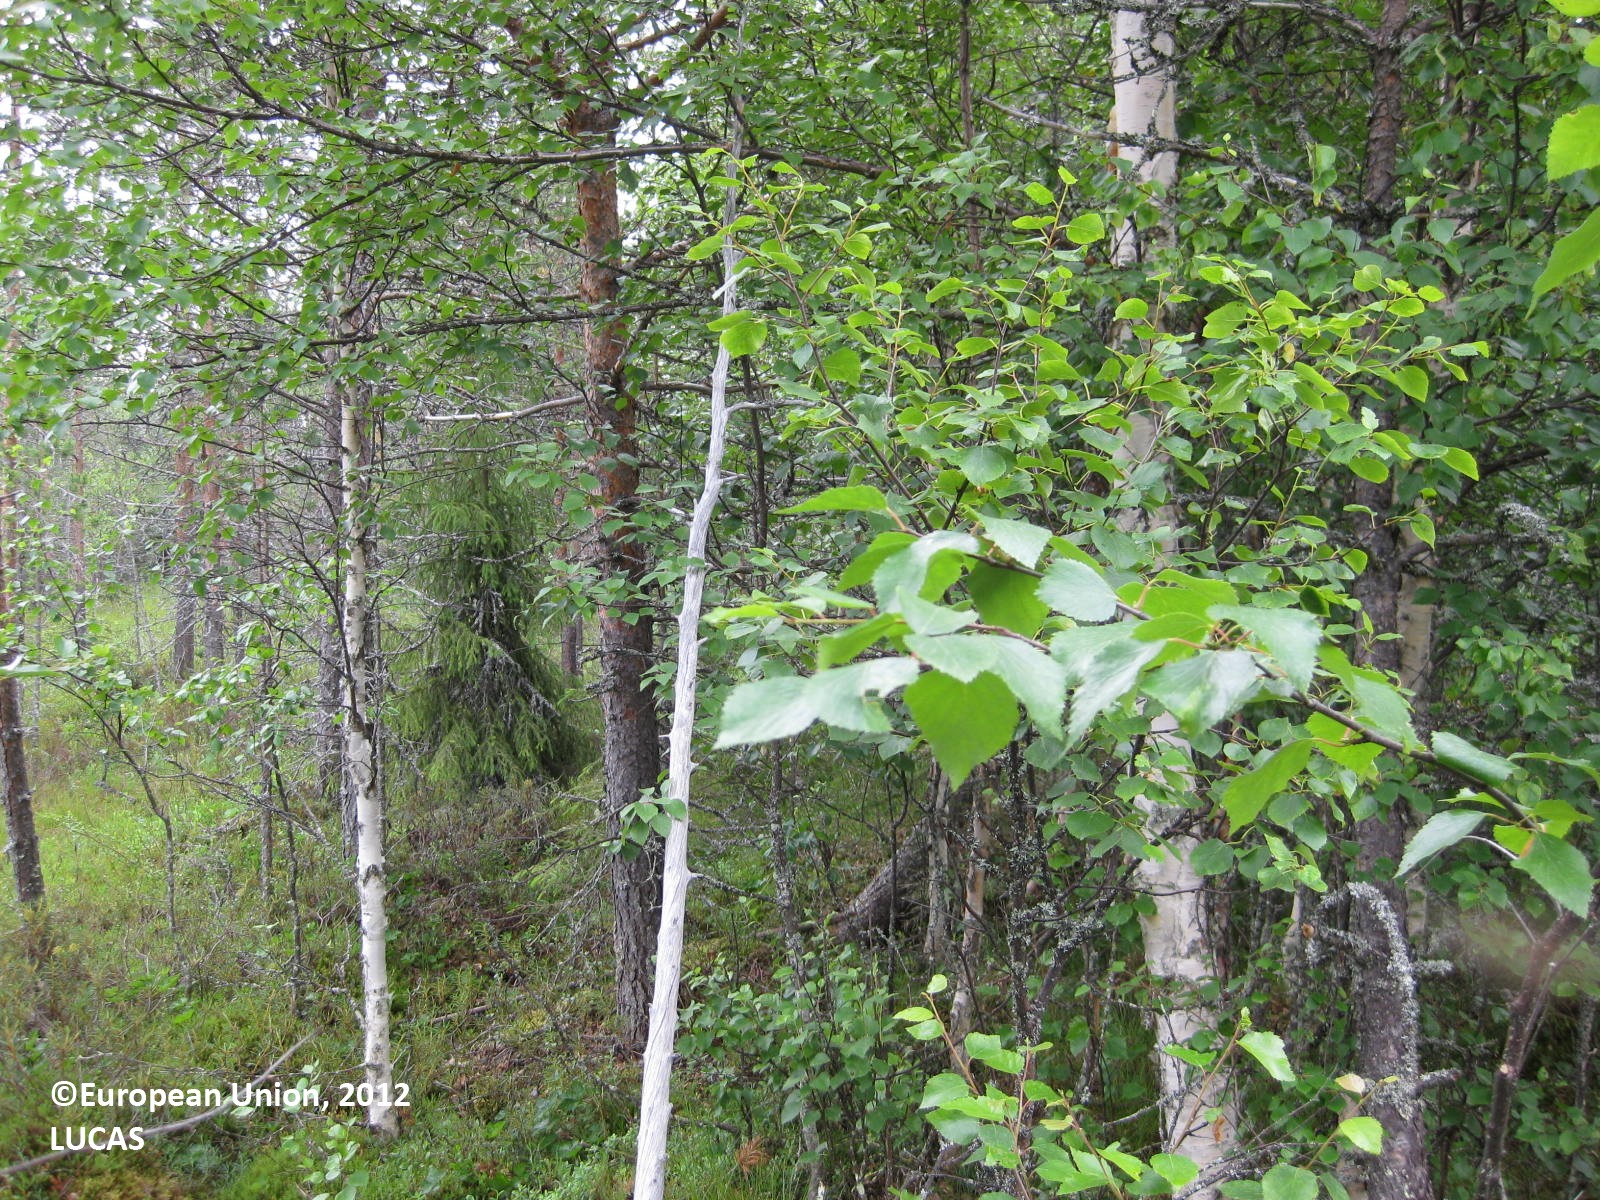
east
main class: Woodland
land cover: Pine dominated mixed woodland
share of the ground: > 75 %
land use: Forestry
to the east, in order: Pine dominated mixed woodland; Pine dominated coniferous woodland; Pine dominated mixed woodland; Ditches and canals; Pine dominated mixed woodland; Ditches and canals; Pine dominated mixed woodland; Ditches and canals; Pine dominated mixed woodland; Pine dominated coniferous woodland
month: July
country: FI
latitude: 65.7418
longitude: 29.3176
